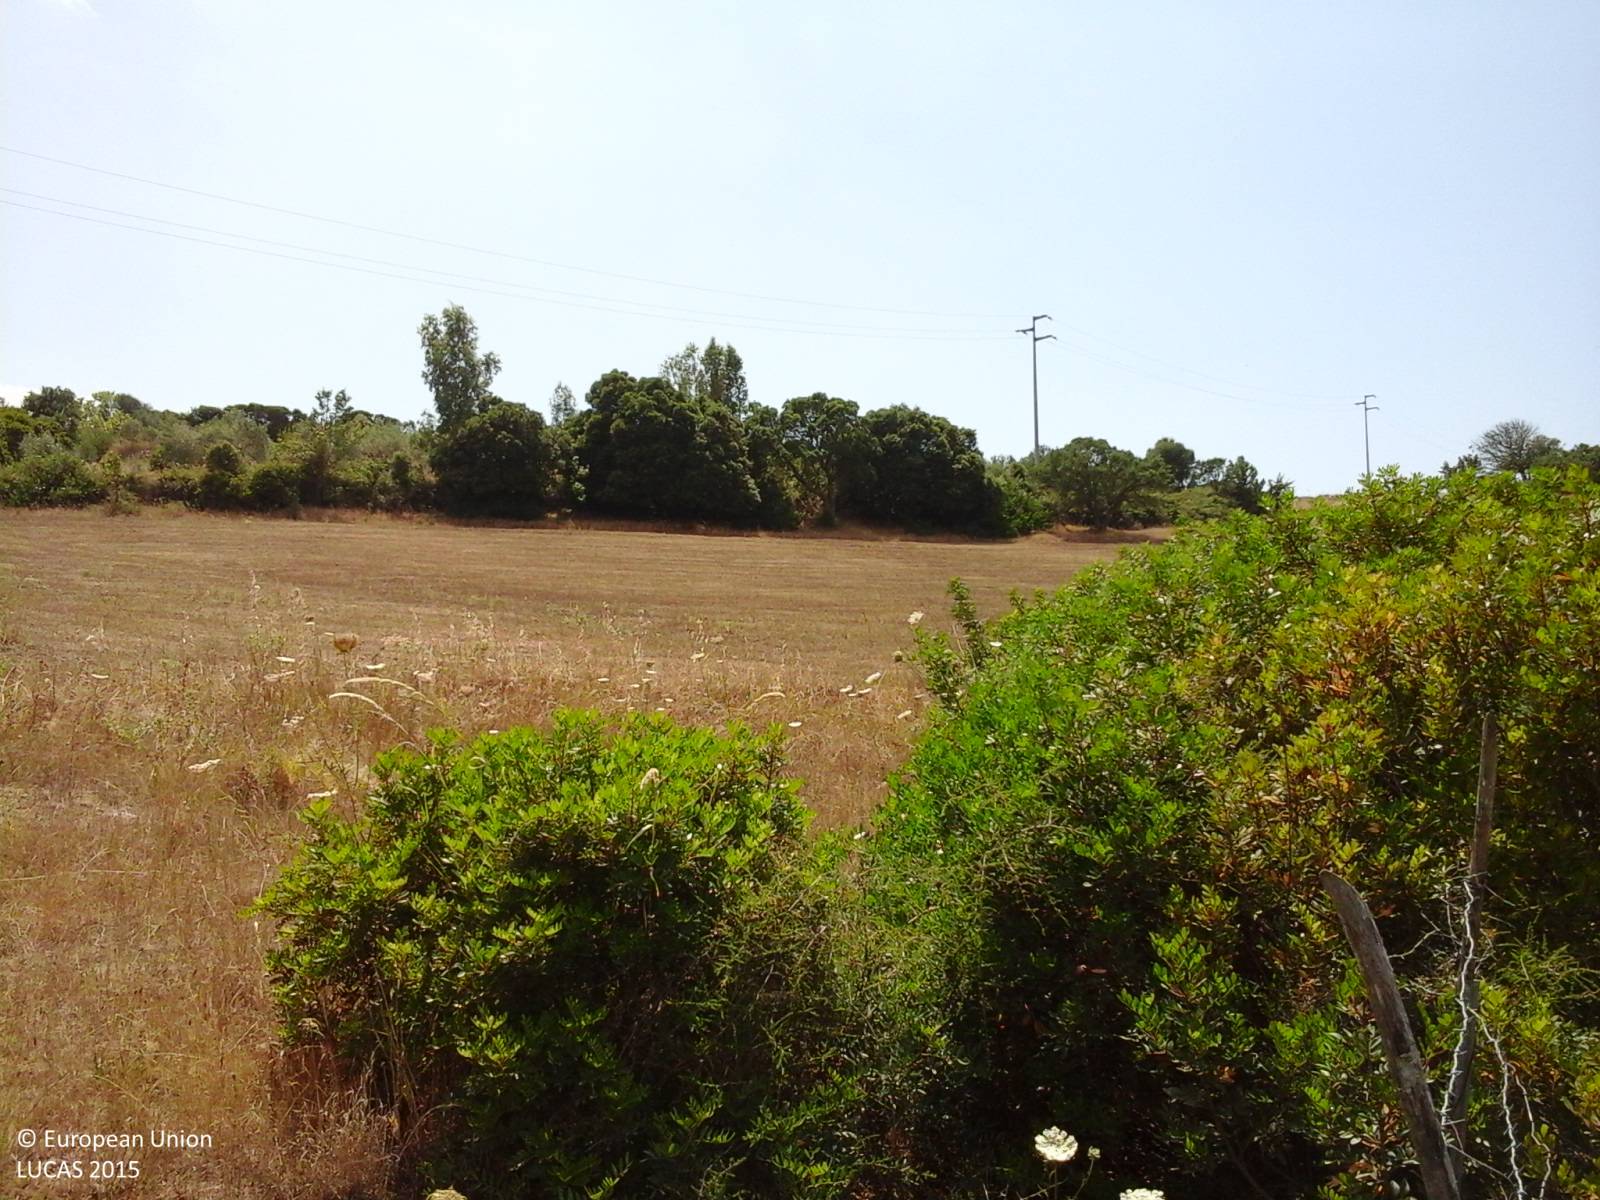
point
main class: Grassland
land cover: Grassland without tree/shrub cover
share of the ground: > 75 %
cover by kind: herbaceous plants 100 %
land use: Agriculture (excluding fallow land and kitchen gardens)
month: June
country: IT
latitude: 39.8627
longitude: 8.8956
